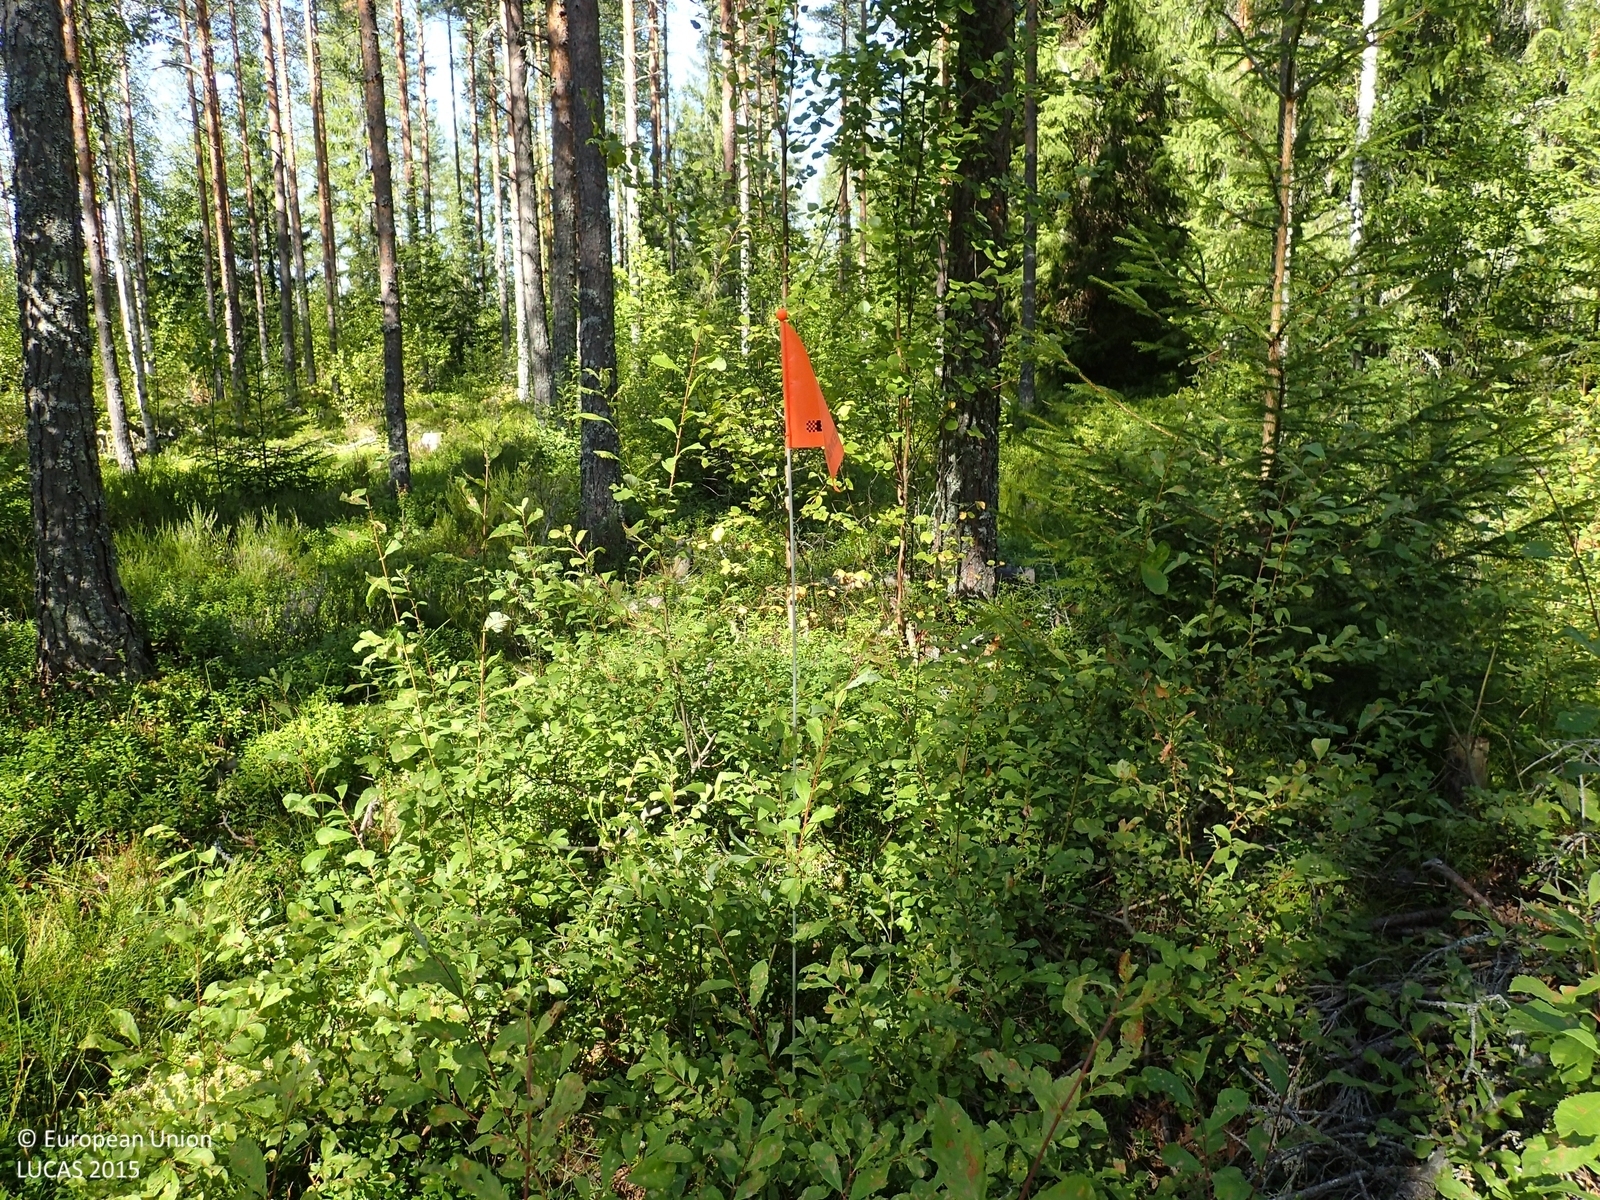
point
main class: Woodland
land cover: Pine dominated mixed woodland
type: boreal forest
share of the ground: > 75 %
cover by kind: coniferous forest trees 55 %, broadleaved forest trees 20 %, shrubs 20 %, herbaceous plants 5 %
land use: Forestry
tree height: > 5 m
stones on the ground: < 10 %
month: August
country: FI
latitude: 62.5564
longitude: 21.9314
